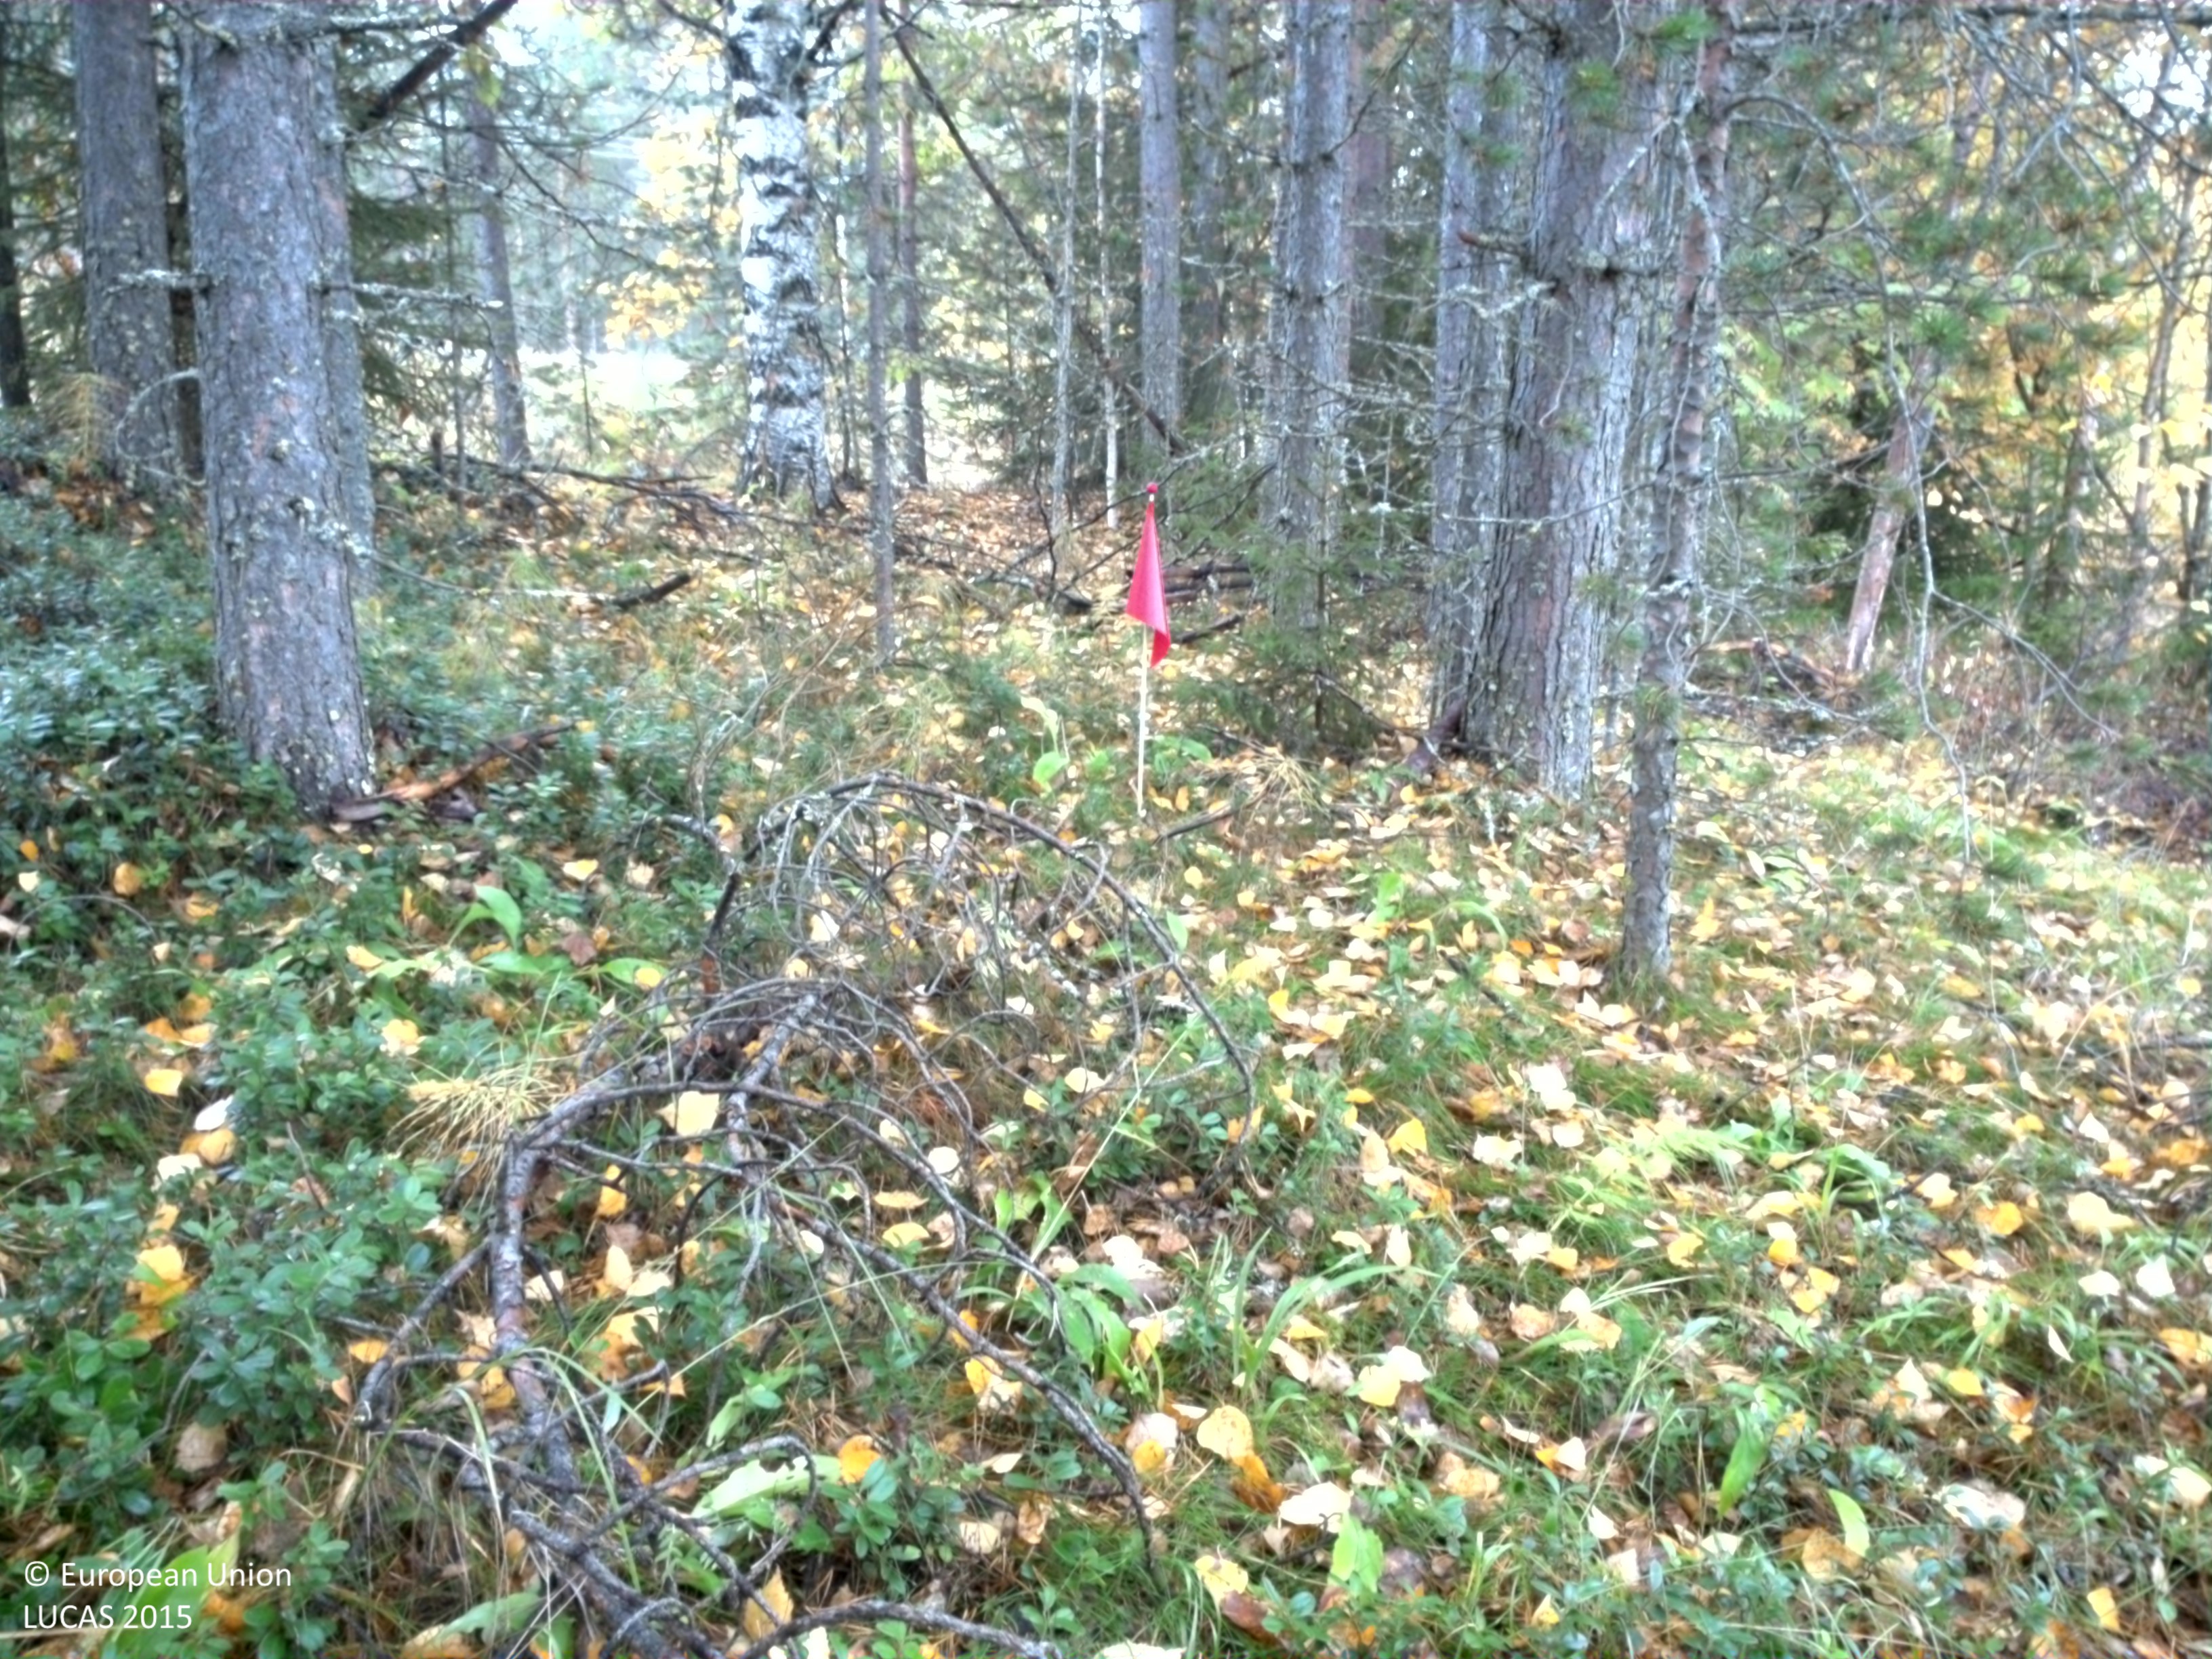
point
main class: Woodland
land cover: Pine dominated mixed woodland
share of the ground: 25 - 50 %
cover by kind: herbaceous plants 35 %, coniferous forest trees 25 %, shrubs 25 %, broadleaved forest trees 15 %
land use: Forestry
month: September
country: SE
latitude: 65.8479
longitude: 21.4692
